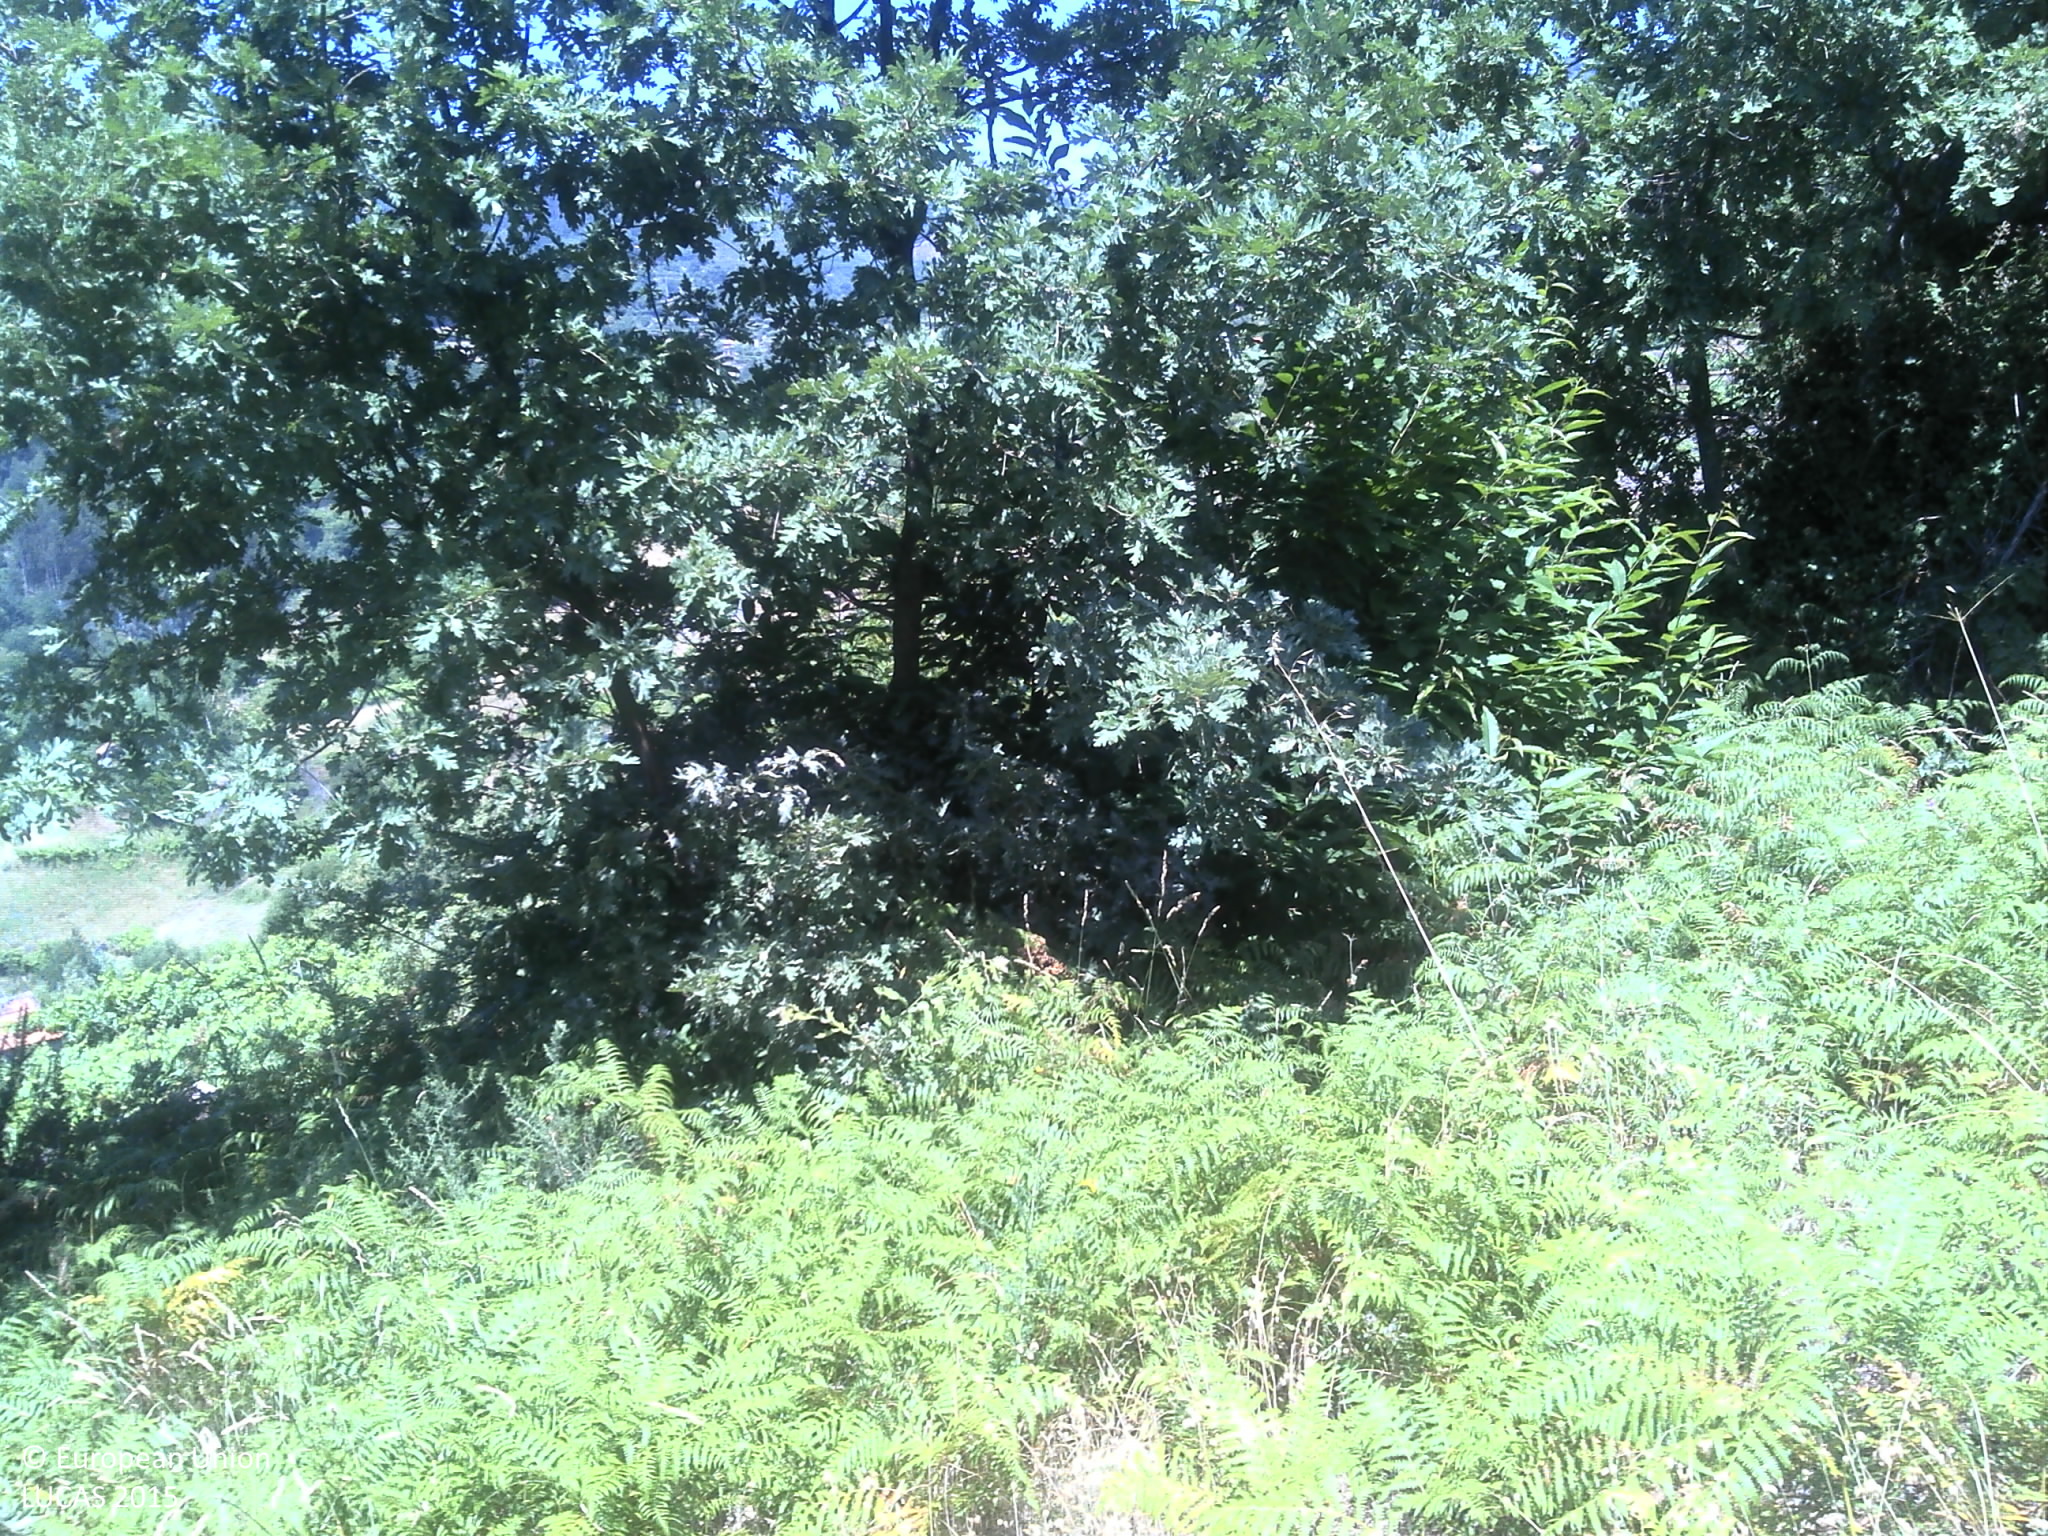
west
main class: Shrubland
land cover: Shrubland with sparse tree cover
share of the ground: 50 - 75 %
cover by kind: shrubs 60 %, herbaceous plants 20 %, consolidated bare surface 10 %, broadleaved forest trees 5 %, unconsolidated bare surface 5 %
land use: Agriculture (excluding fallow land and kitchen gardens)
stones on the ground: 25 - 50 %
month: June
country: PT
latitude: 41.1638
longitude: -7.9514
